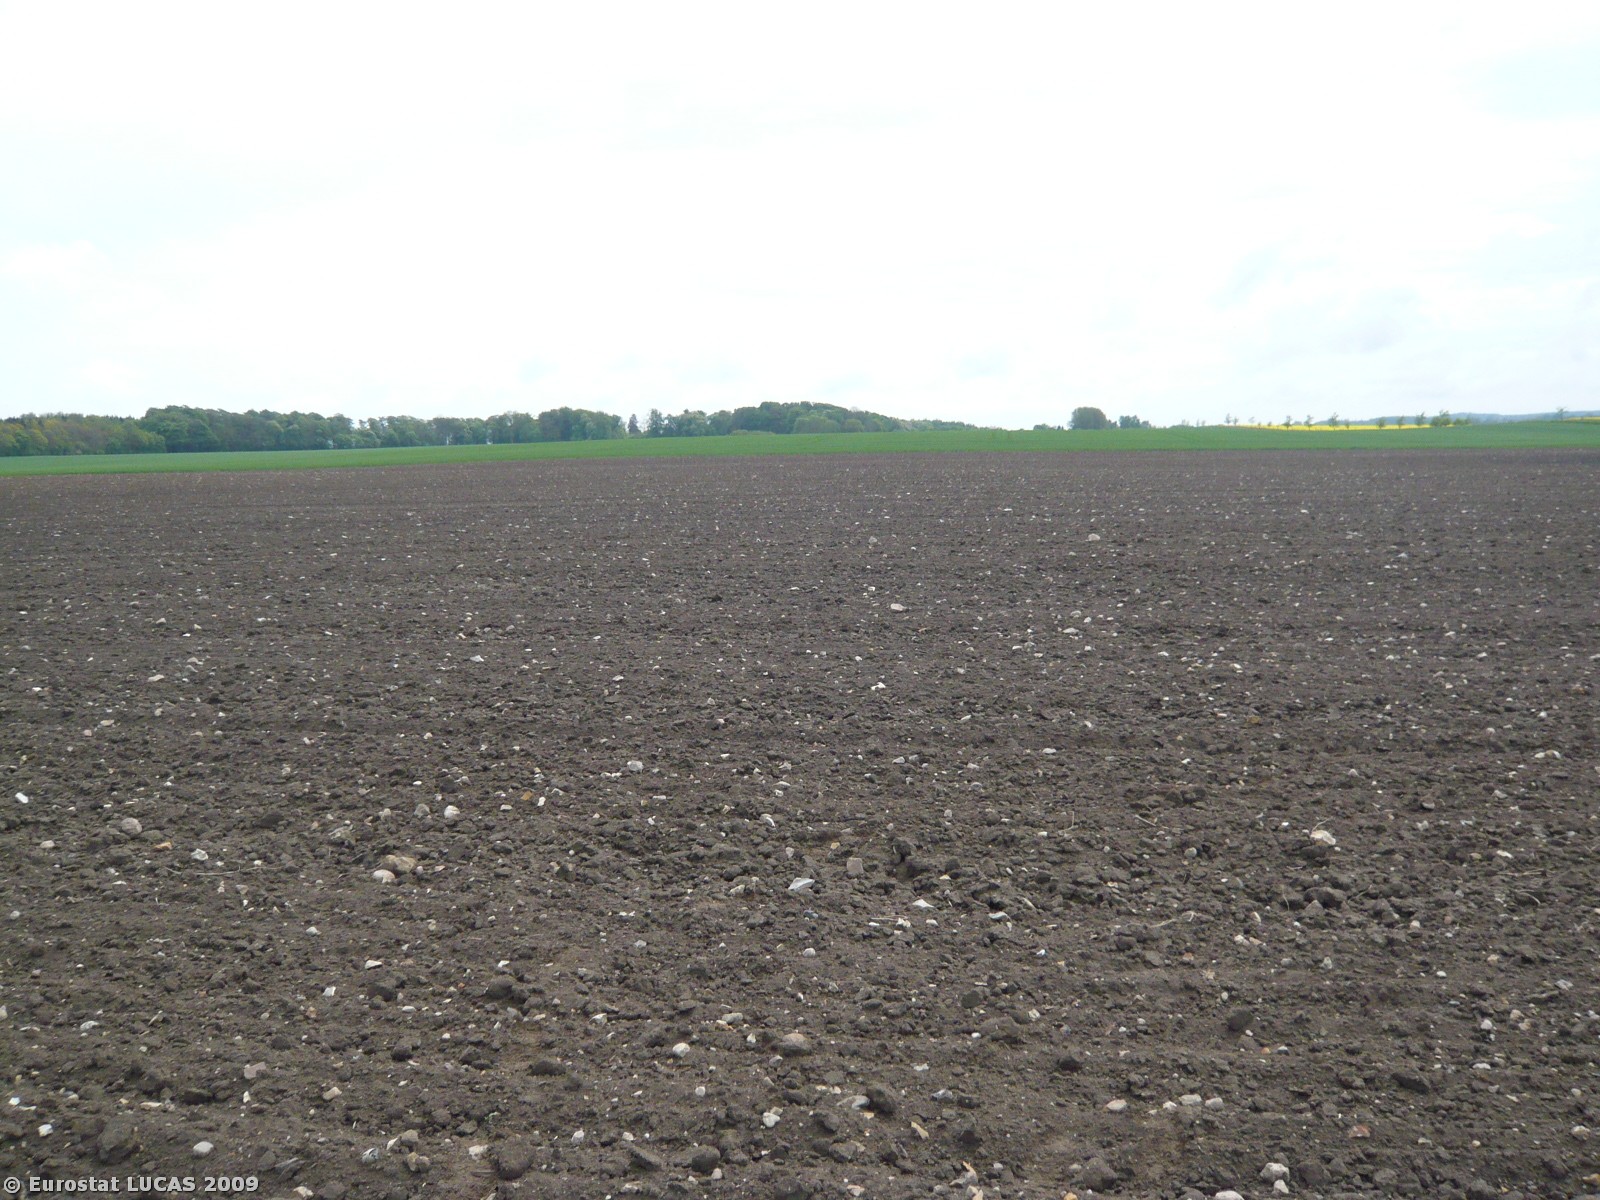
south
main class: Cropland
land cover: Other root crops
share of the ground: < 10 %
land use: Agriculture (excluding fallow land and kitchen gardens)
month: May
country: DK
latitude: 55.2722
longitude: 12.0604
